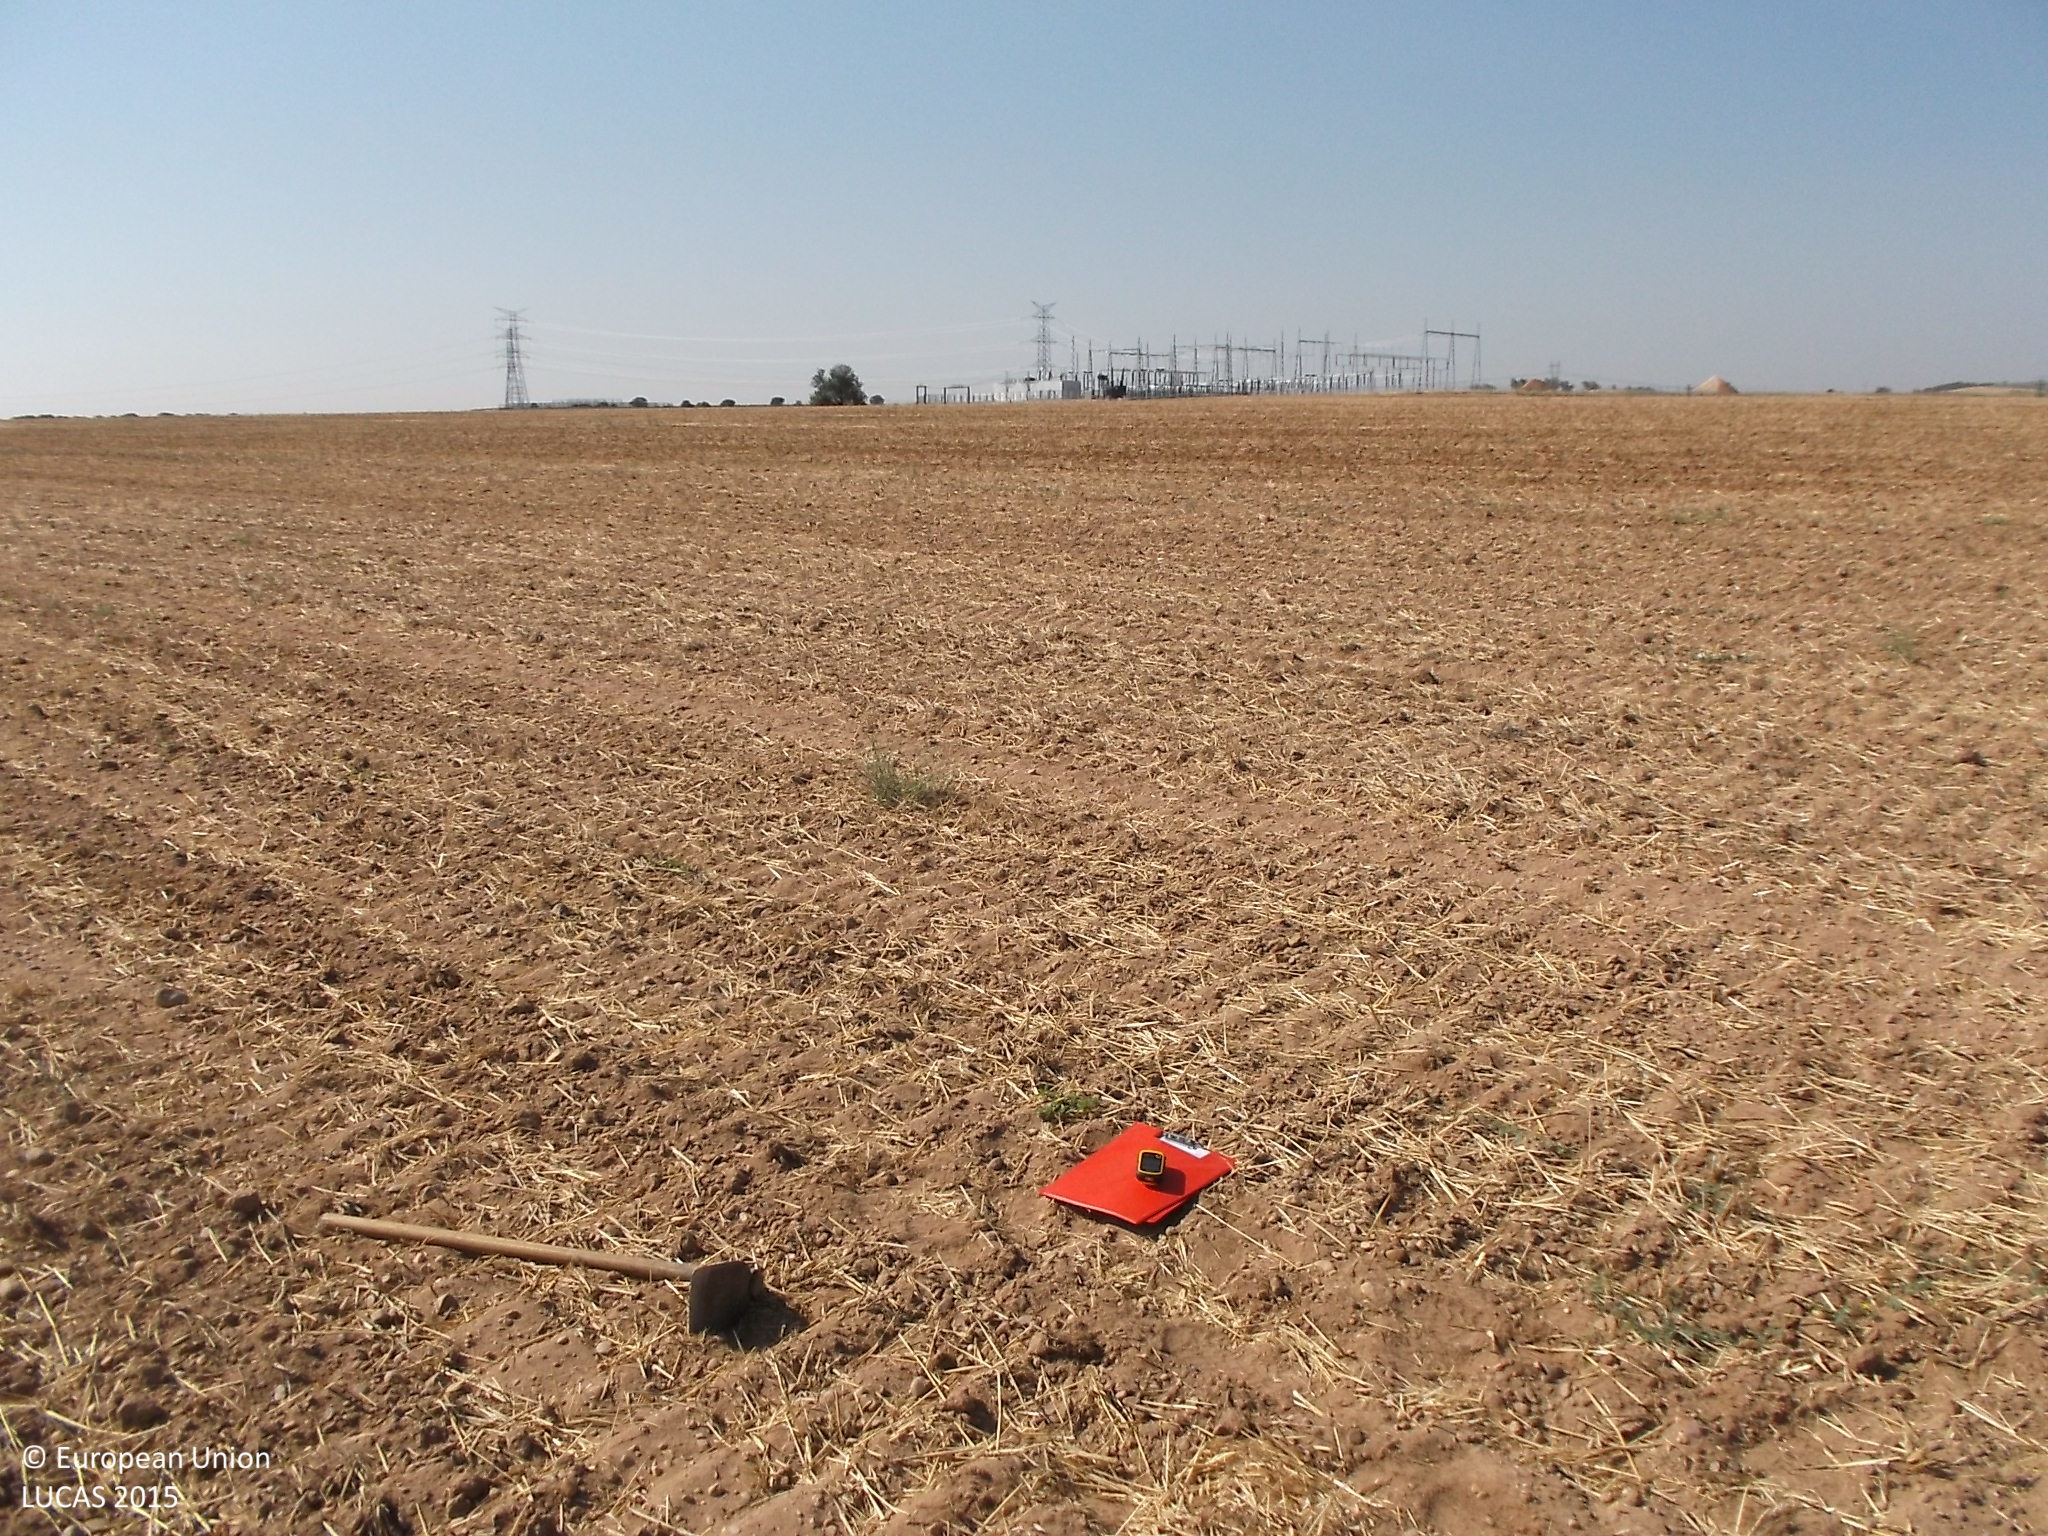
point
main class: Cropland
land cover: Oats
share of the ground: < 10 %
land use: Agriculture (excluding fallow land and kitchen gardens)
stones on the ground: 10 - 25 %
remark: Harvested field
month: July
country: ES
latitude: 41.4551
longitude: -5.3655
